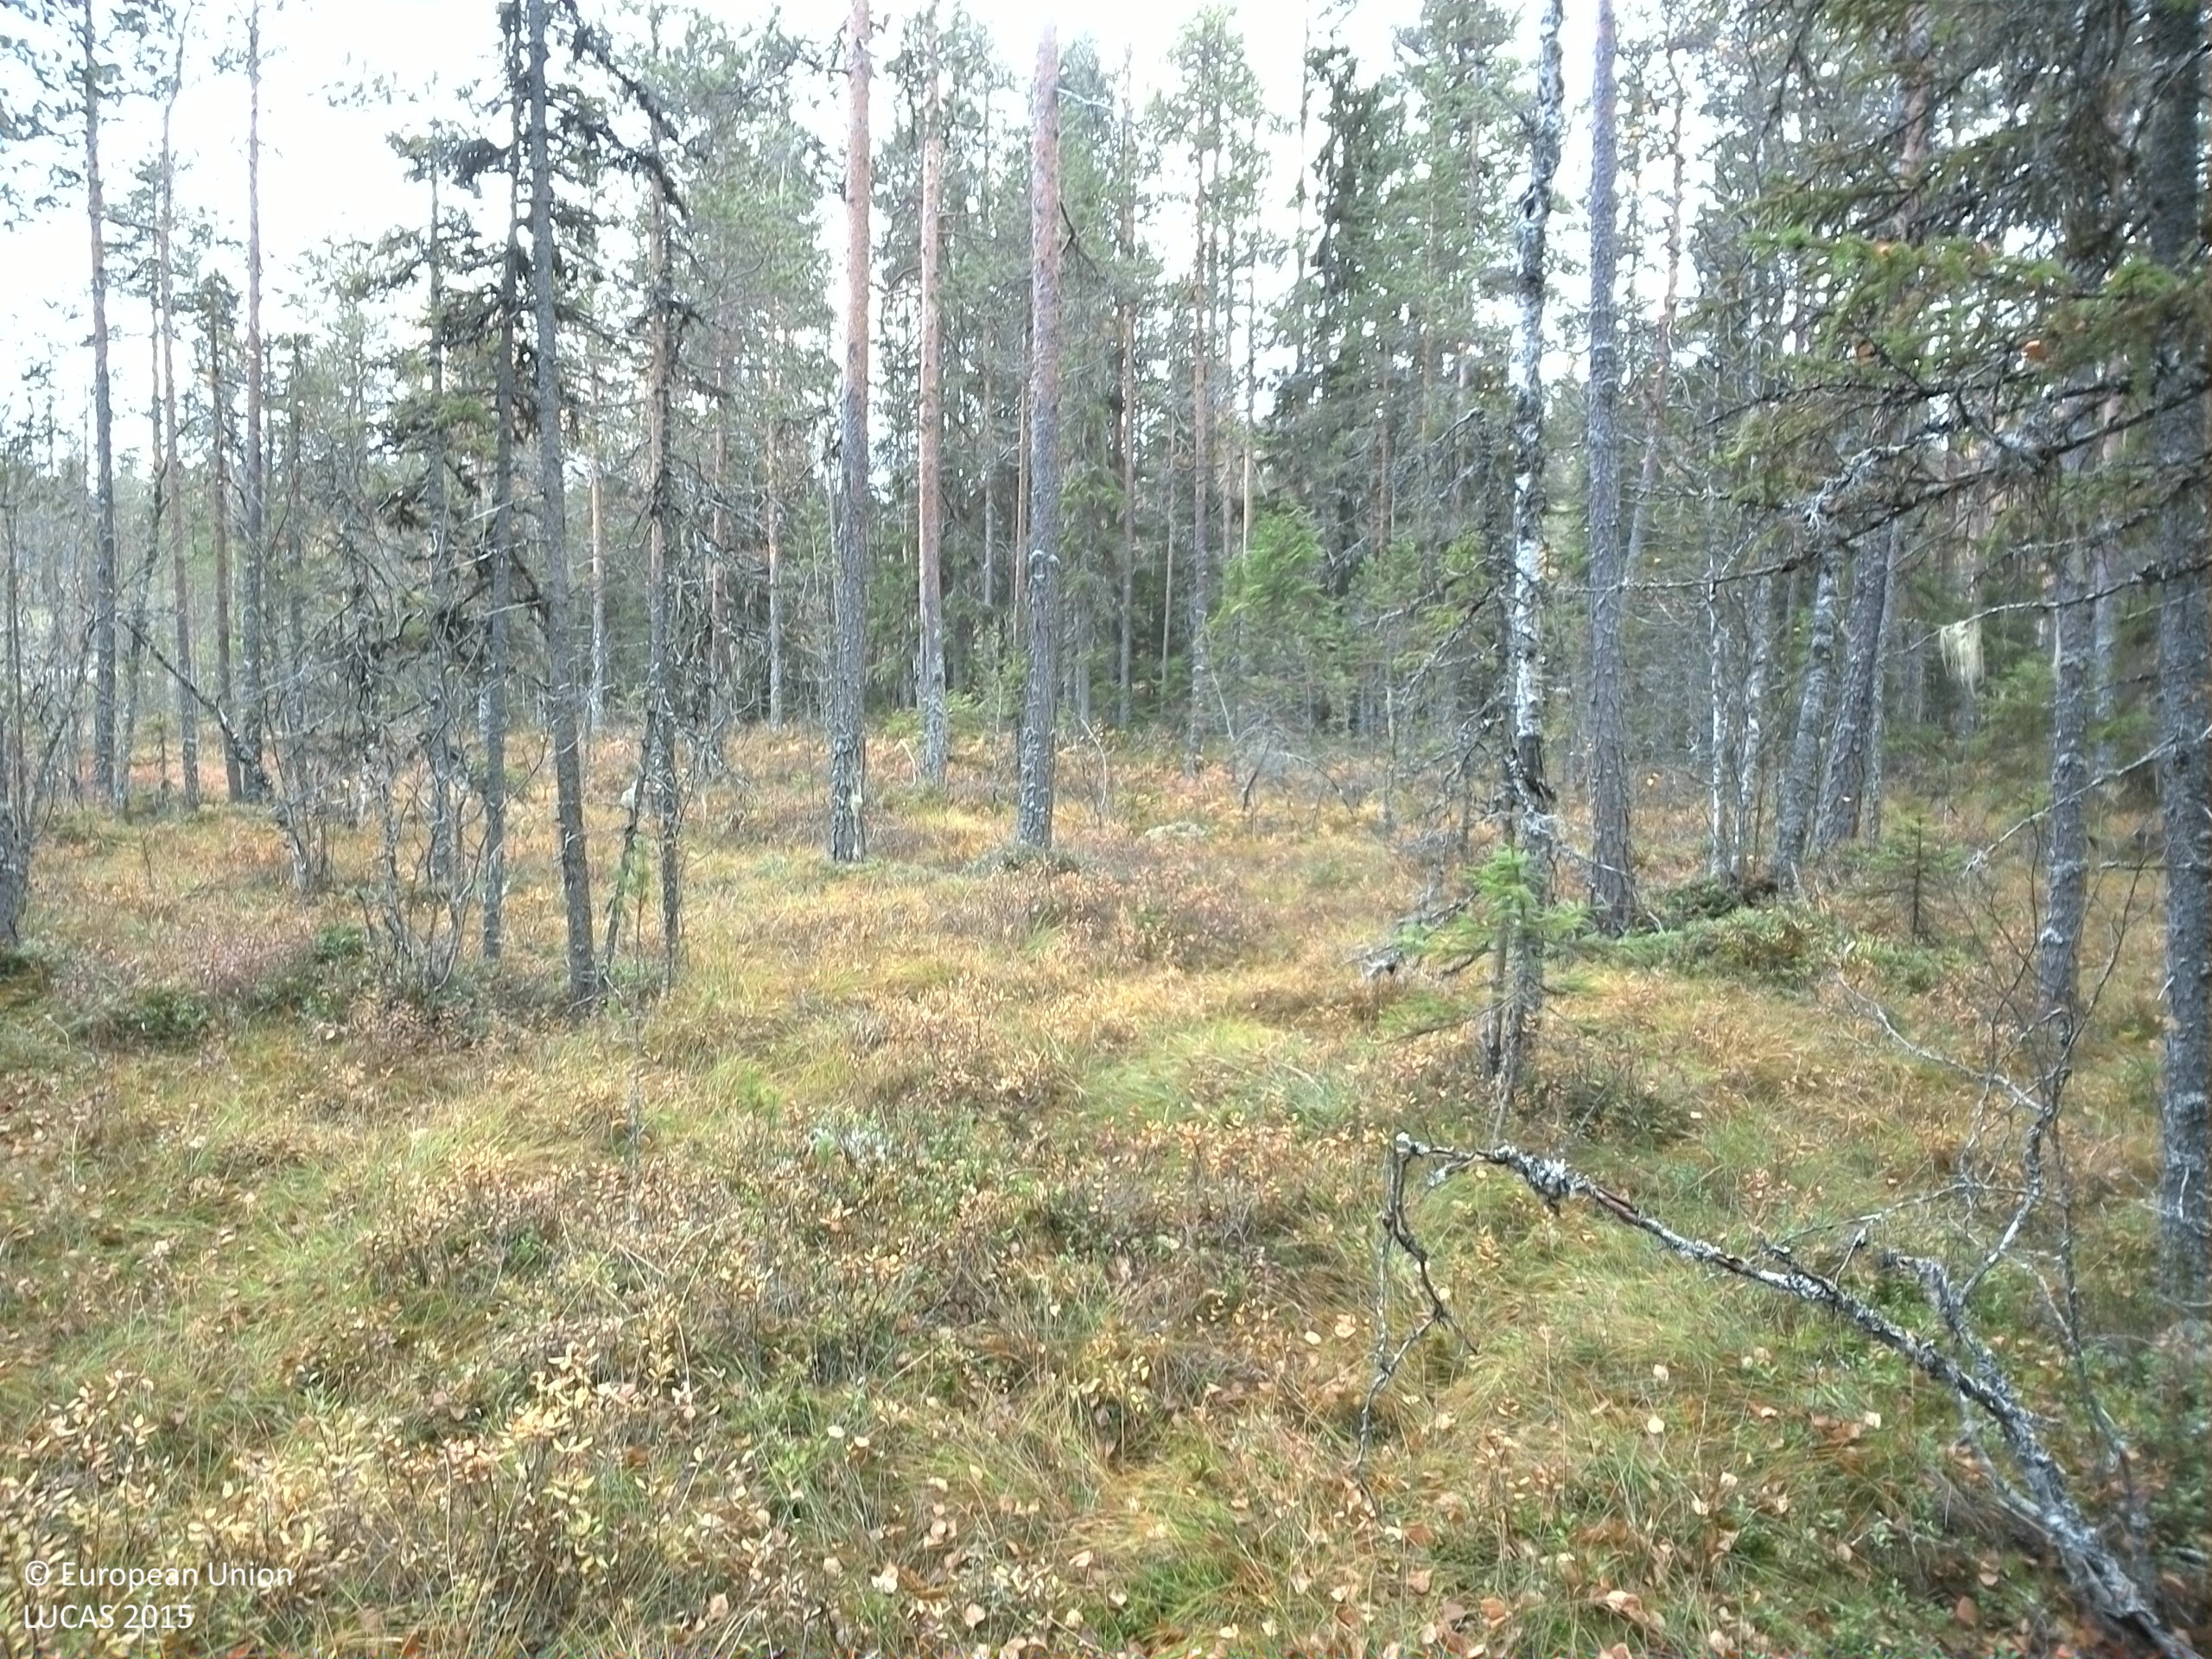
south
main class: Woodland
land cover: Pine dominated mixed woodland
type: boreal forest
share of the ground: 50 - 75 %
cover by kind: coniferous forest trees 35 %, shrubs 20 %, lichens and mosses 20 %, broadleaved forest trees 15 %, herbaceous plants 10 %
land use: Forestry
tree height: > 5 m
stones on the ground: < 10 %
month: October
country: SE
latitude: 61.2527
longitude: 14.2546
